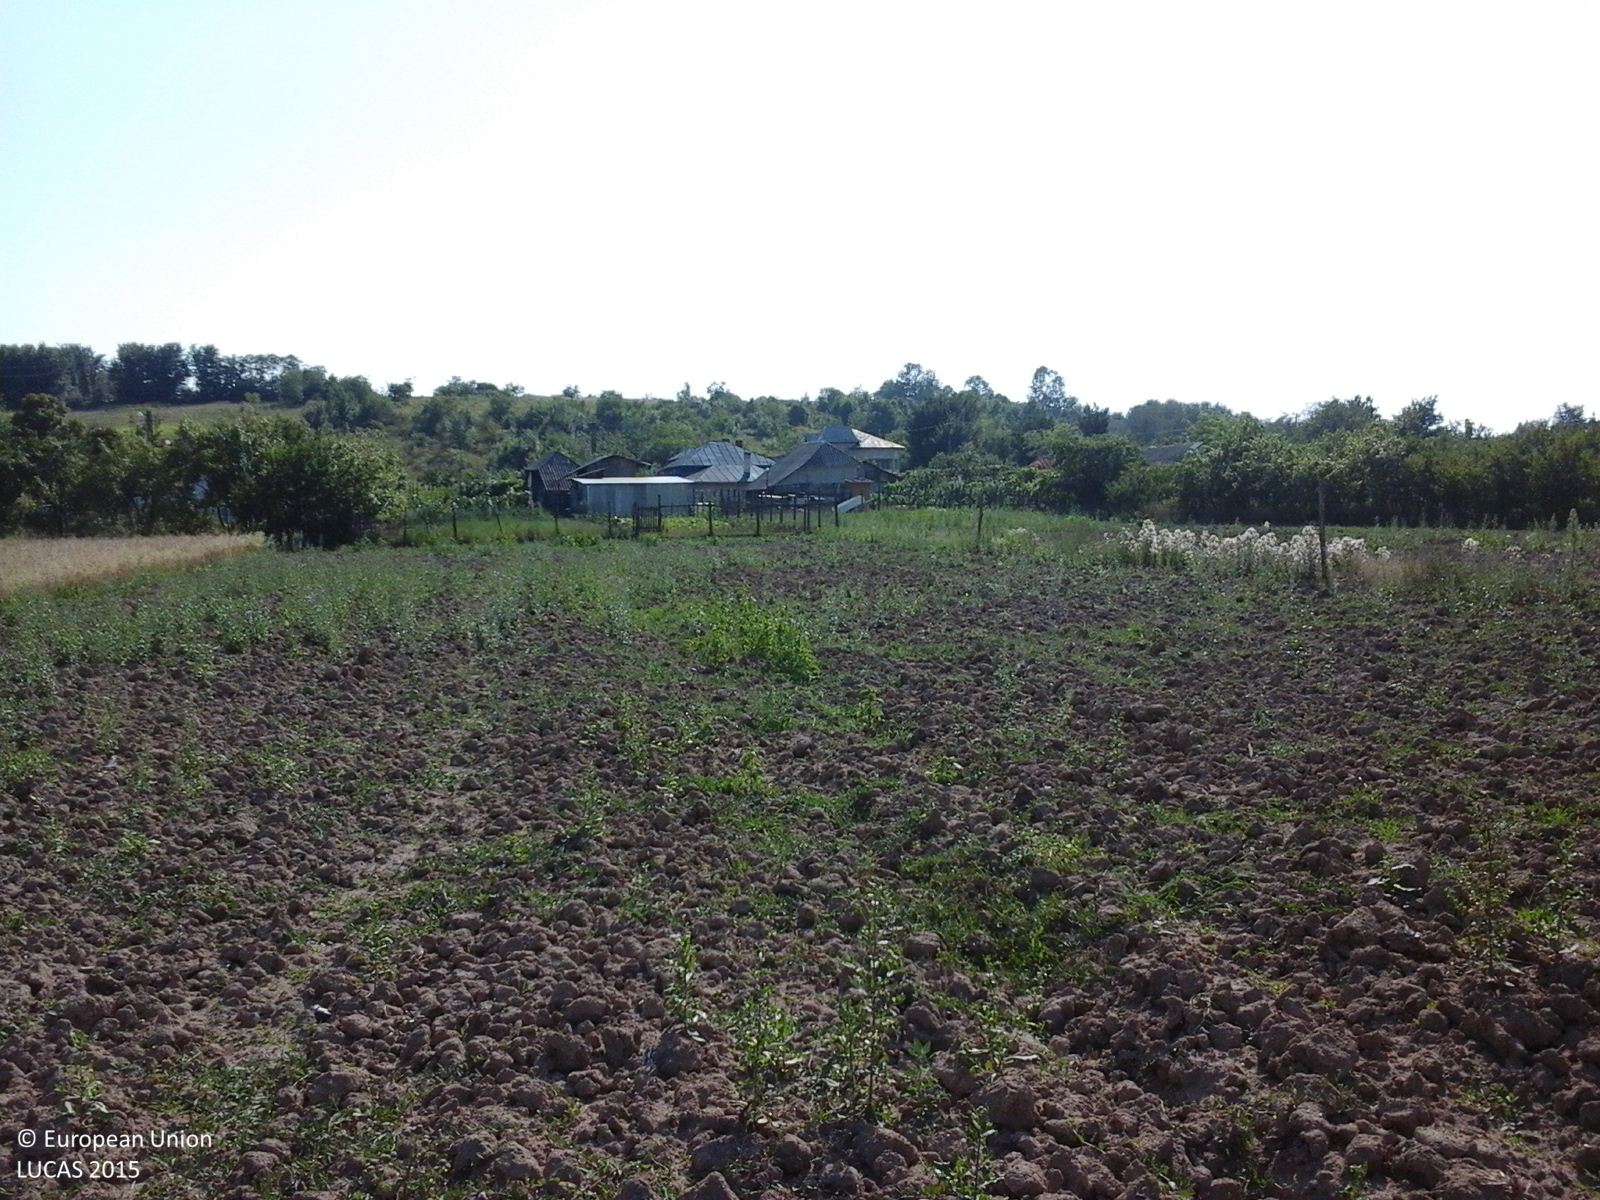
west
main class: Grassland
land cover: Spontaneously vegetated surfaces
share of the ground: 10 - 25 %
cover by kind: unconsolidated bare surface 85 %, herbaceous plants 15 %
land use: Agriculture (excluding fallow land and kitchen gardens)
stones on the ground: < 10 %
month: July
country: RO
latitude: 44.6952
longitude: 24.6509
